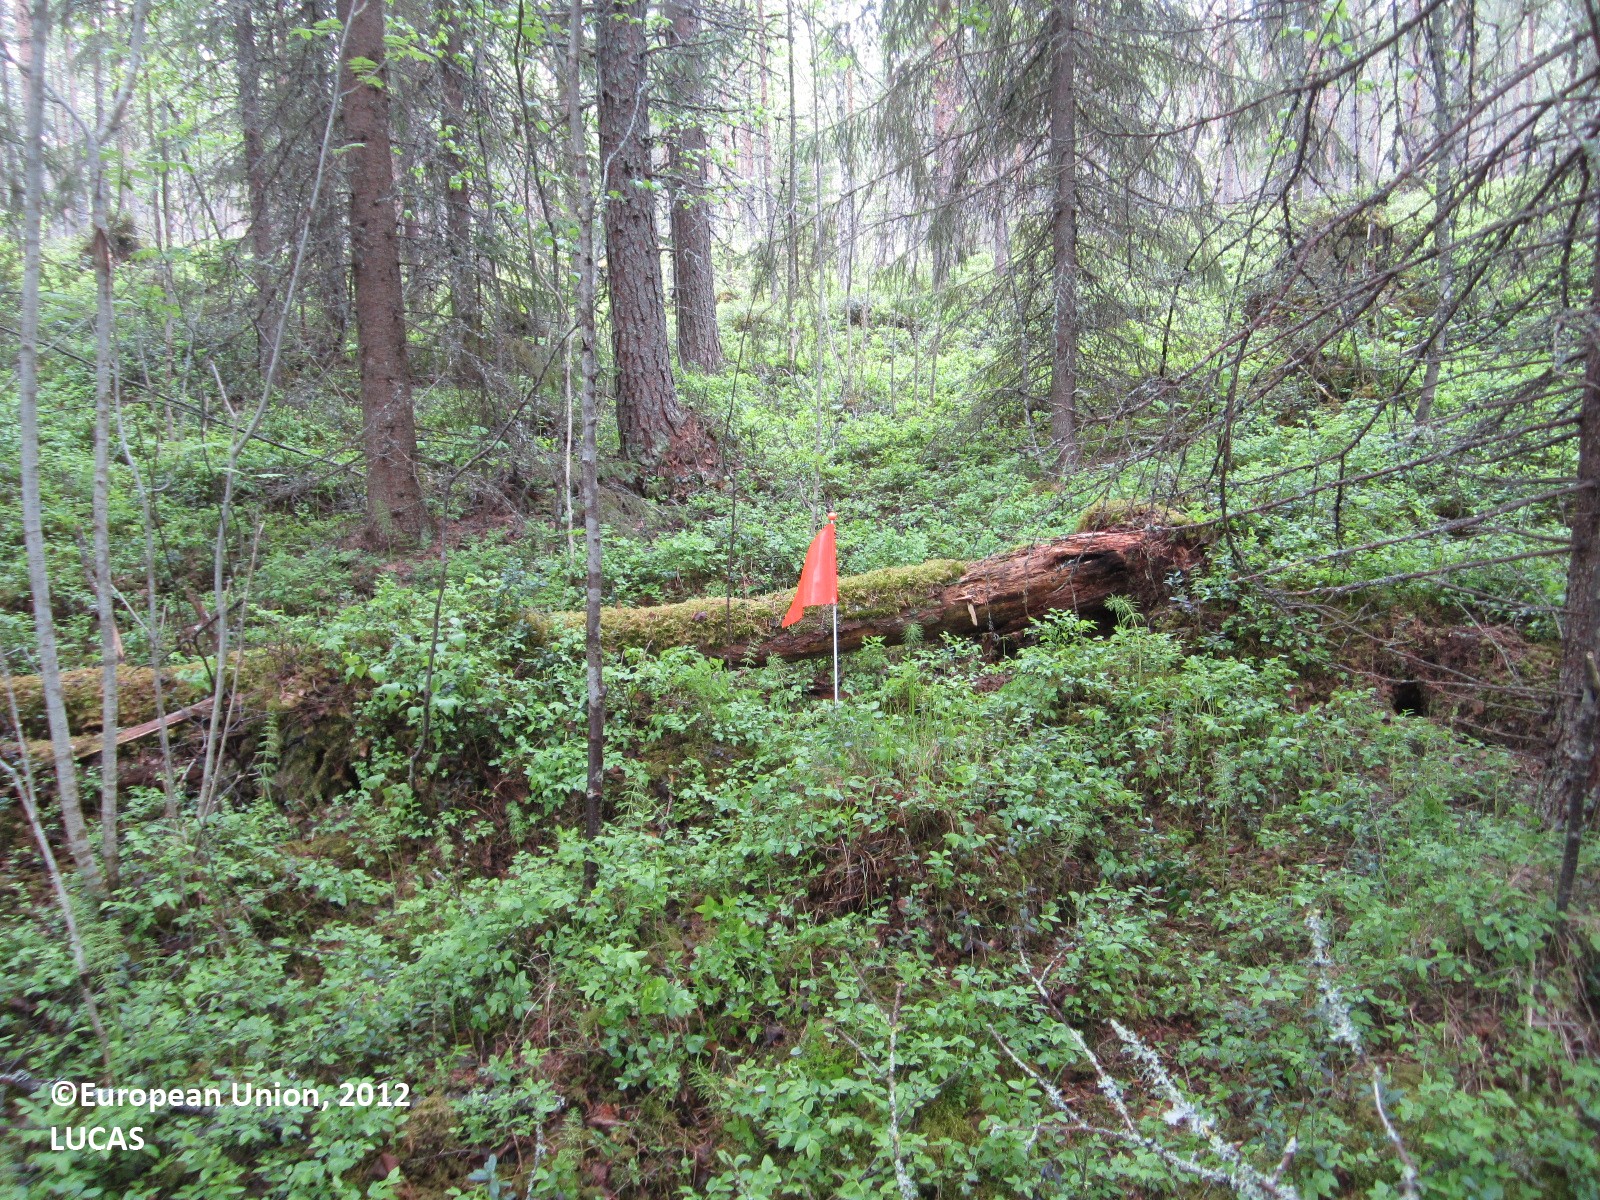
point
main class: Woodland
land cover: Pine dominated mixed woodland
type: boreal forest
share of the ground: > 75 %
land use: Forestry
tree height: > 5 m
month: June
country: FI
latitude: 64.6172
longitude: 28.6846
